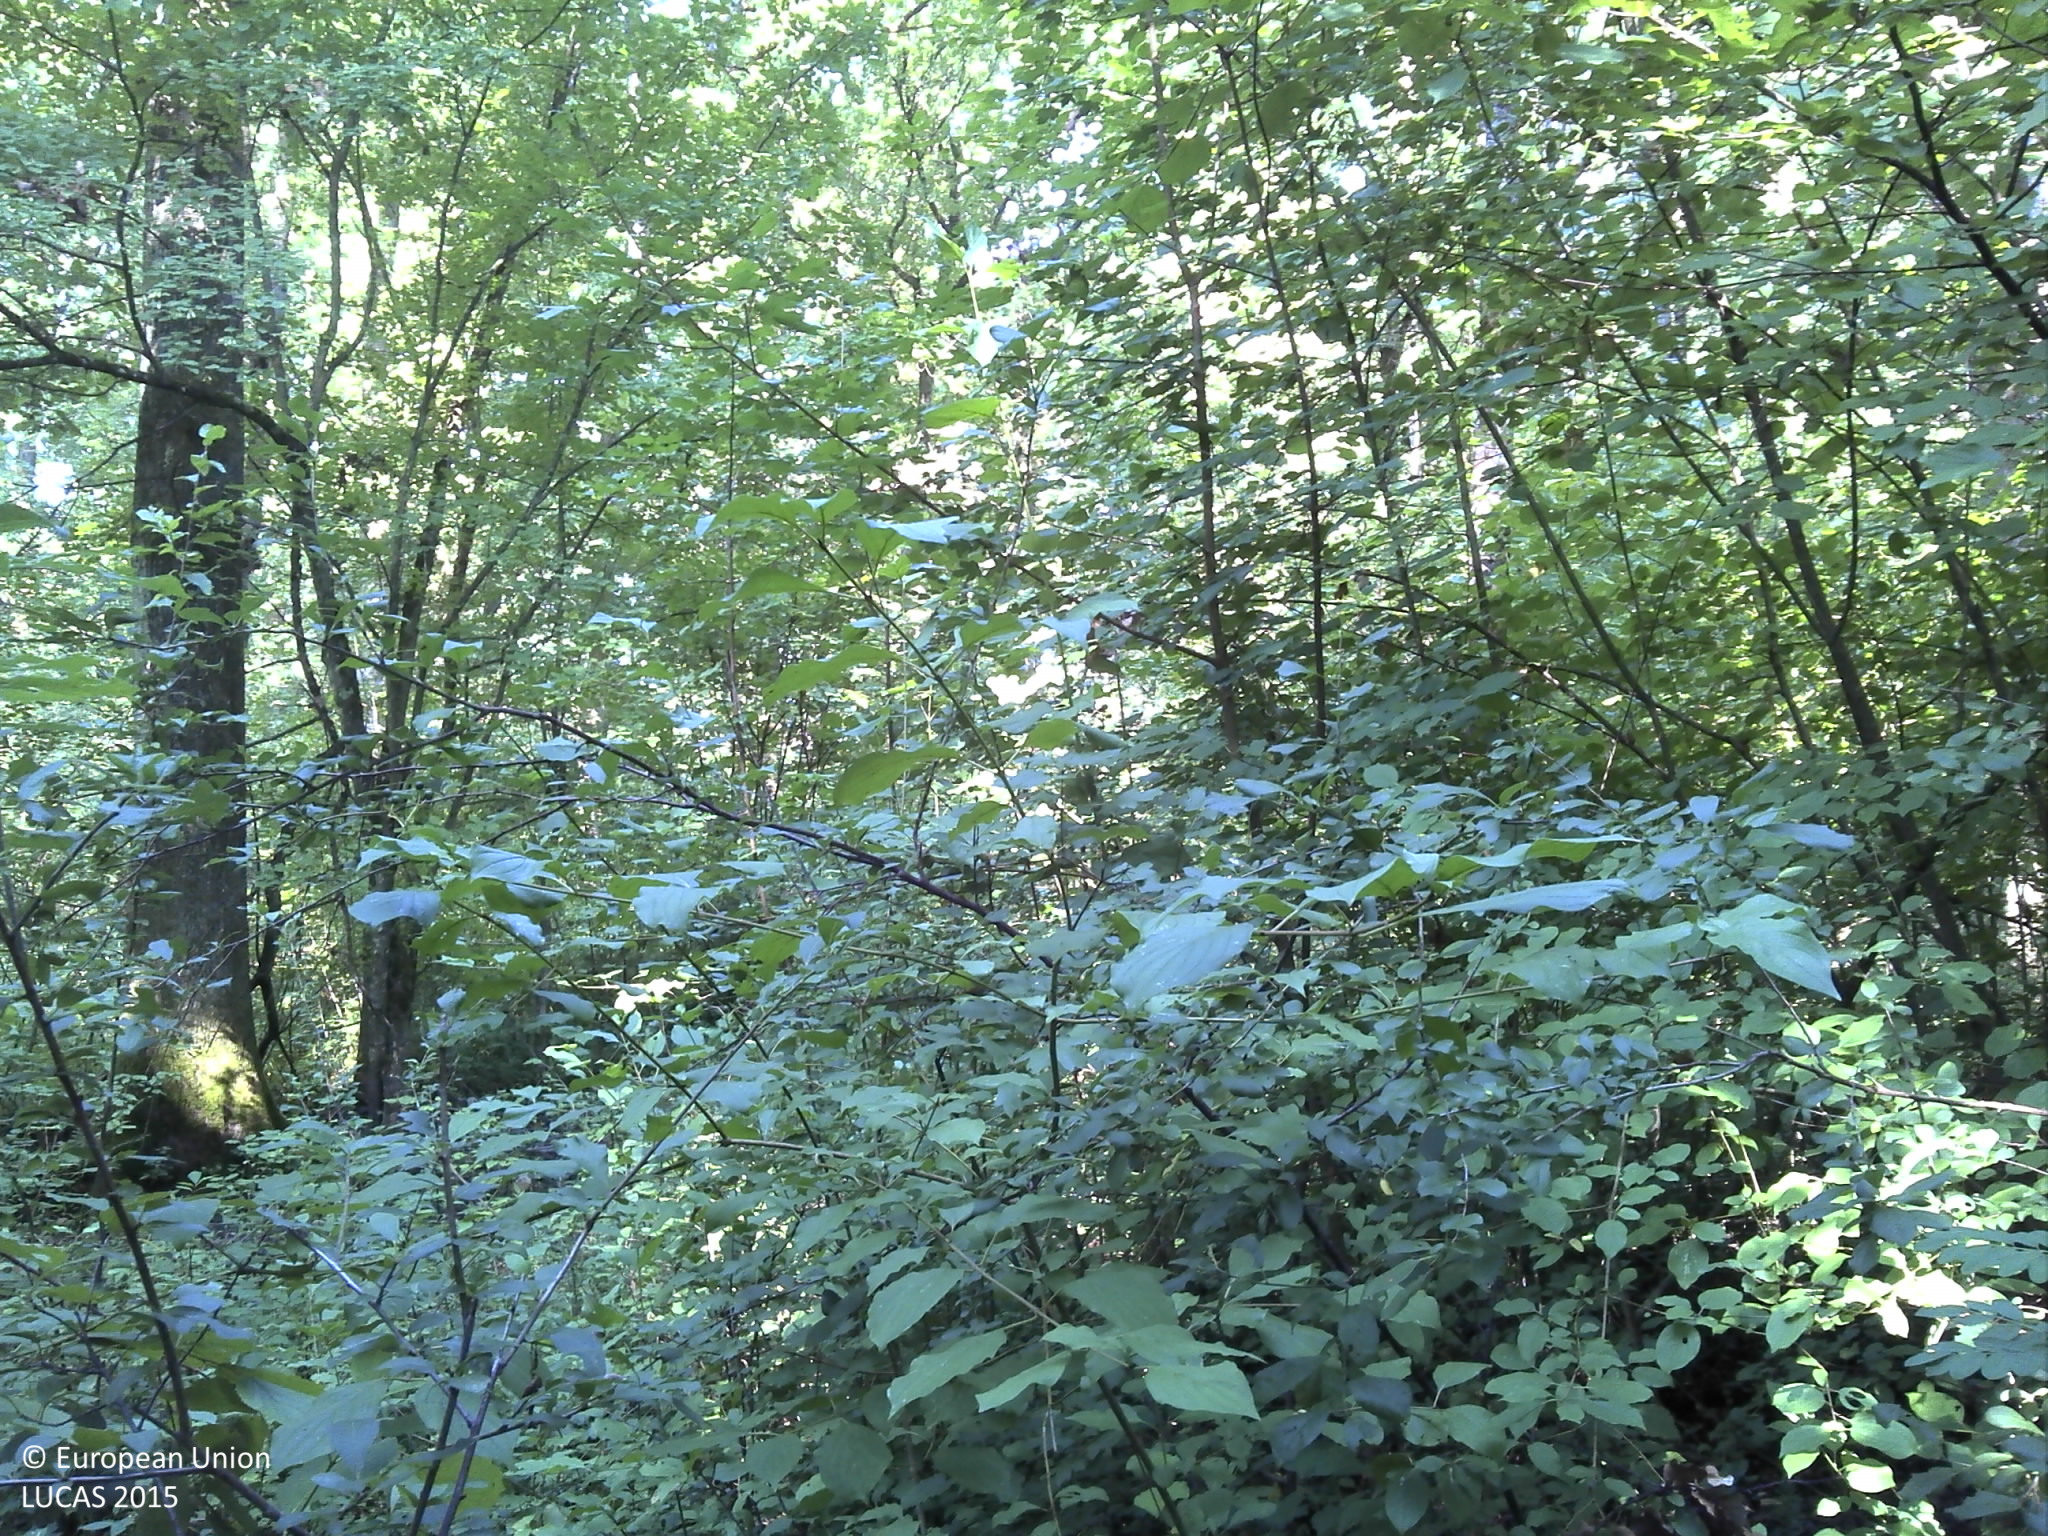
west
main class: Woodland
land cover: Broadleaved woodland
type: acidophilous oak and oak-birch forest
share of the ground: > 75 %
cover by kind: broadleaved forest trees 80 %, lichens and mosses 20 %
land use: Forestry
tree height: > 5 m
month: August
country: HR
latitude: 45.5739
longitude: 16.5210
